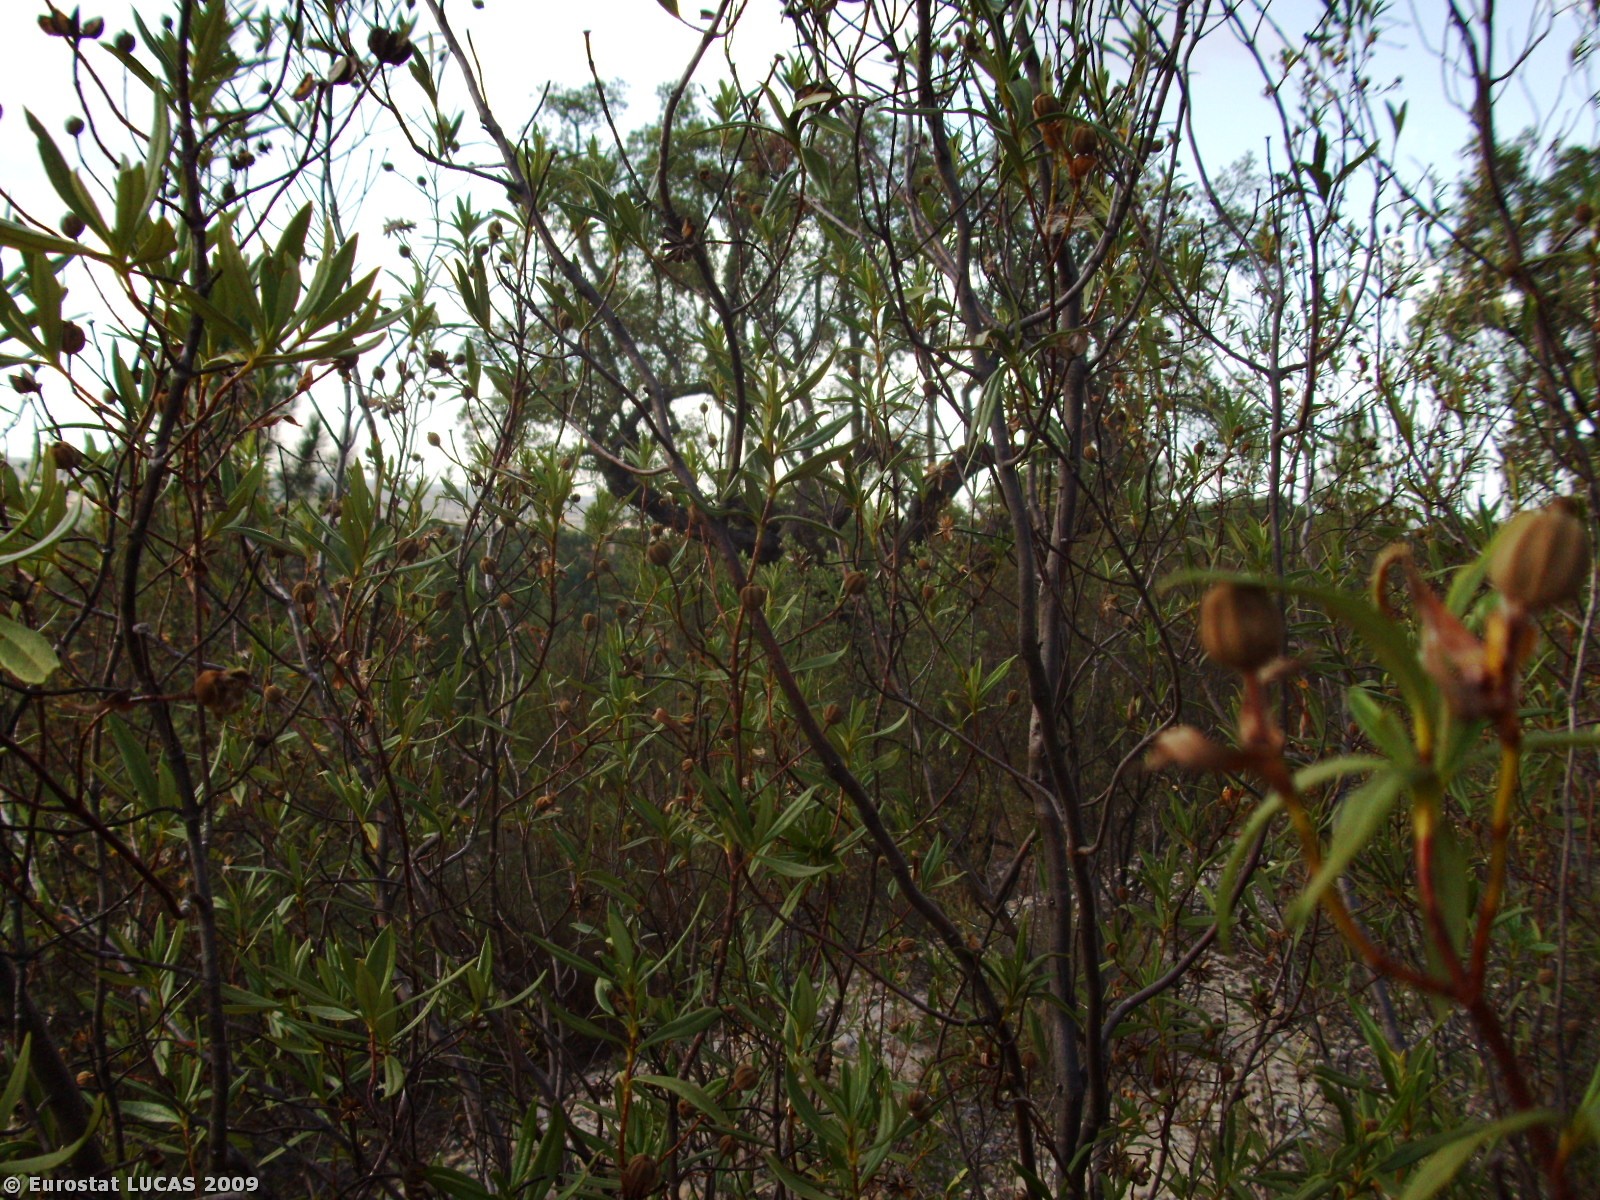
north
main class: Woodland
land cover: Broadleaved woodland
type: broadleaved evergreen forest
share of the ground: 25 - 50 %
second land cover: Shrubland with sparse tree cover
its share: 25 - 50 %
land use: Forestry
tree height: > 5 m
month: August
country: PT
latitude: 39.1904
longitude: -8.0347
